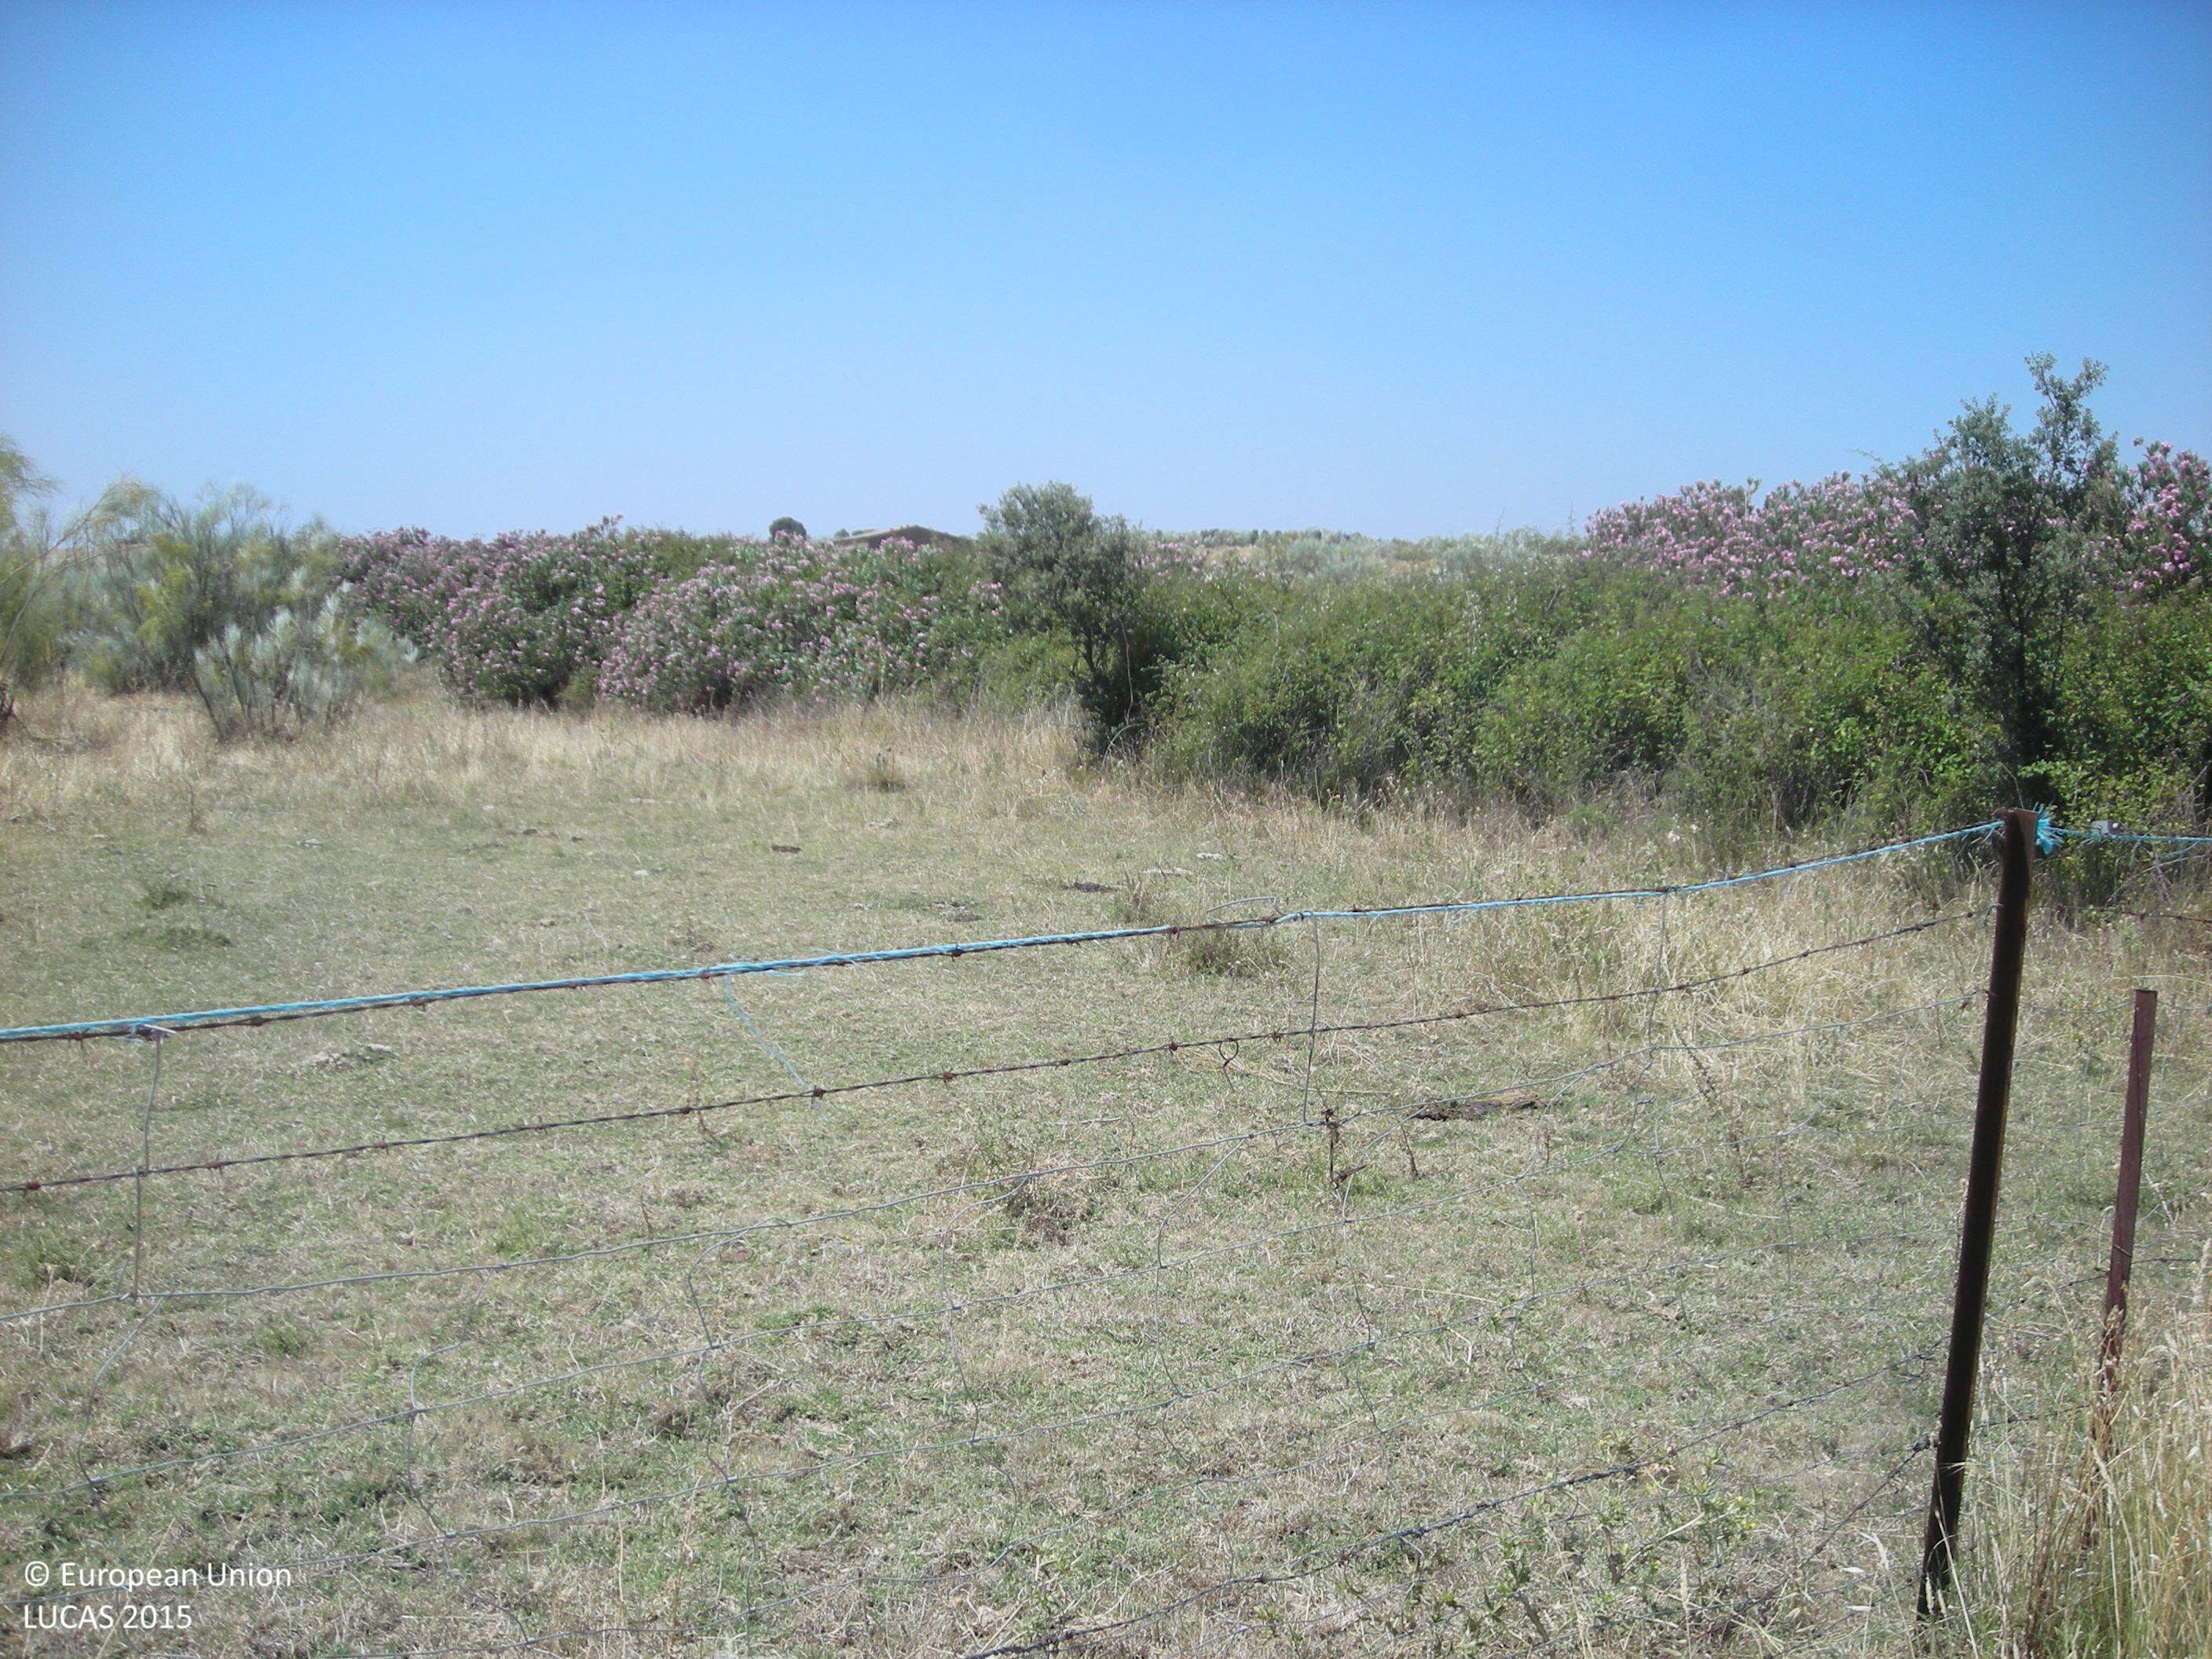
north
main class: Woodland
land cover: Broadleaved woodland
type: broadleaved evergreen forest
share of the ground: 10 - 25 %
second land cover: Grassland without tree/shrub cover
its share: 50 - 75 %
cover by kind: herbaceous plants 60 %, broadleaved forest trees 40 %
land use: Forestry
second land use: Agriculture (excluding fallow land and kitchen gardens)
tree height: > 5 m
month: June
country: ES
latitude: 38.6651
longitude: -5.7998
